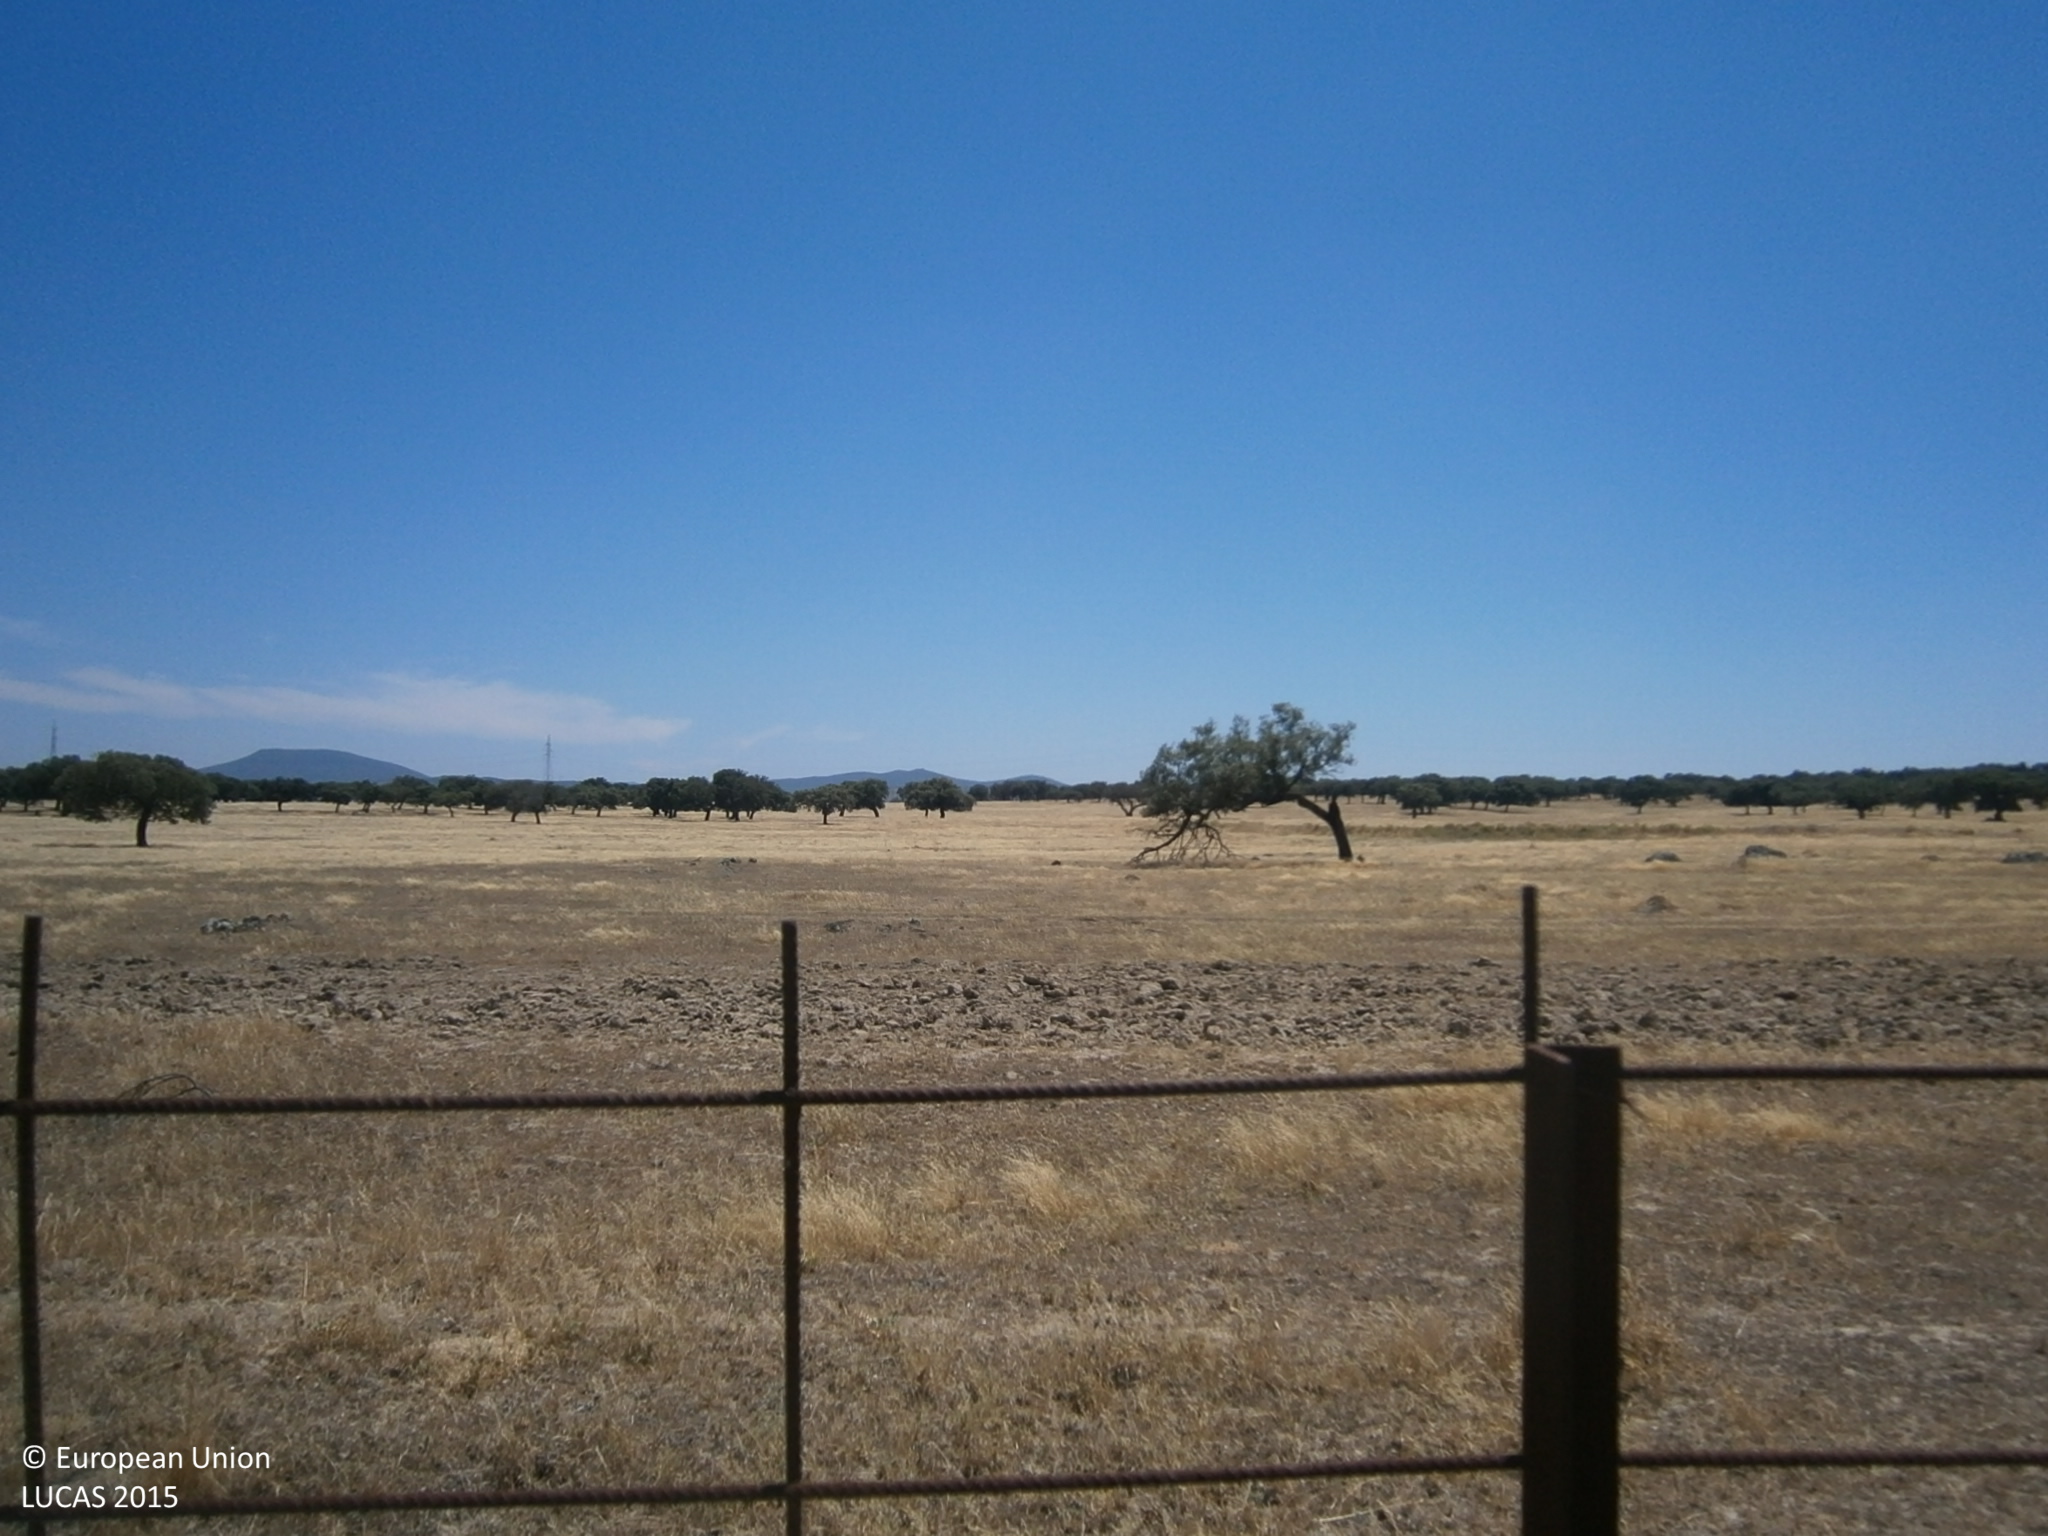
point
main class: Grassland
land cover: Grassland with sparse tree/shrub cover
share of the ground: > 75 %
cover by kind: herbaceous plants 90 %, broadleaved forest trees 5 %, shrubs 5 %
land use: Agriculture (excluding fallow land and kitchen gardens)
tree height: > 5 m
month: June
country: ES
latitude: 38.6288
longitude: -6.8684
